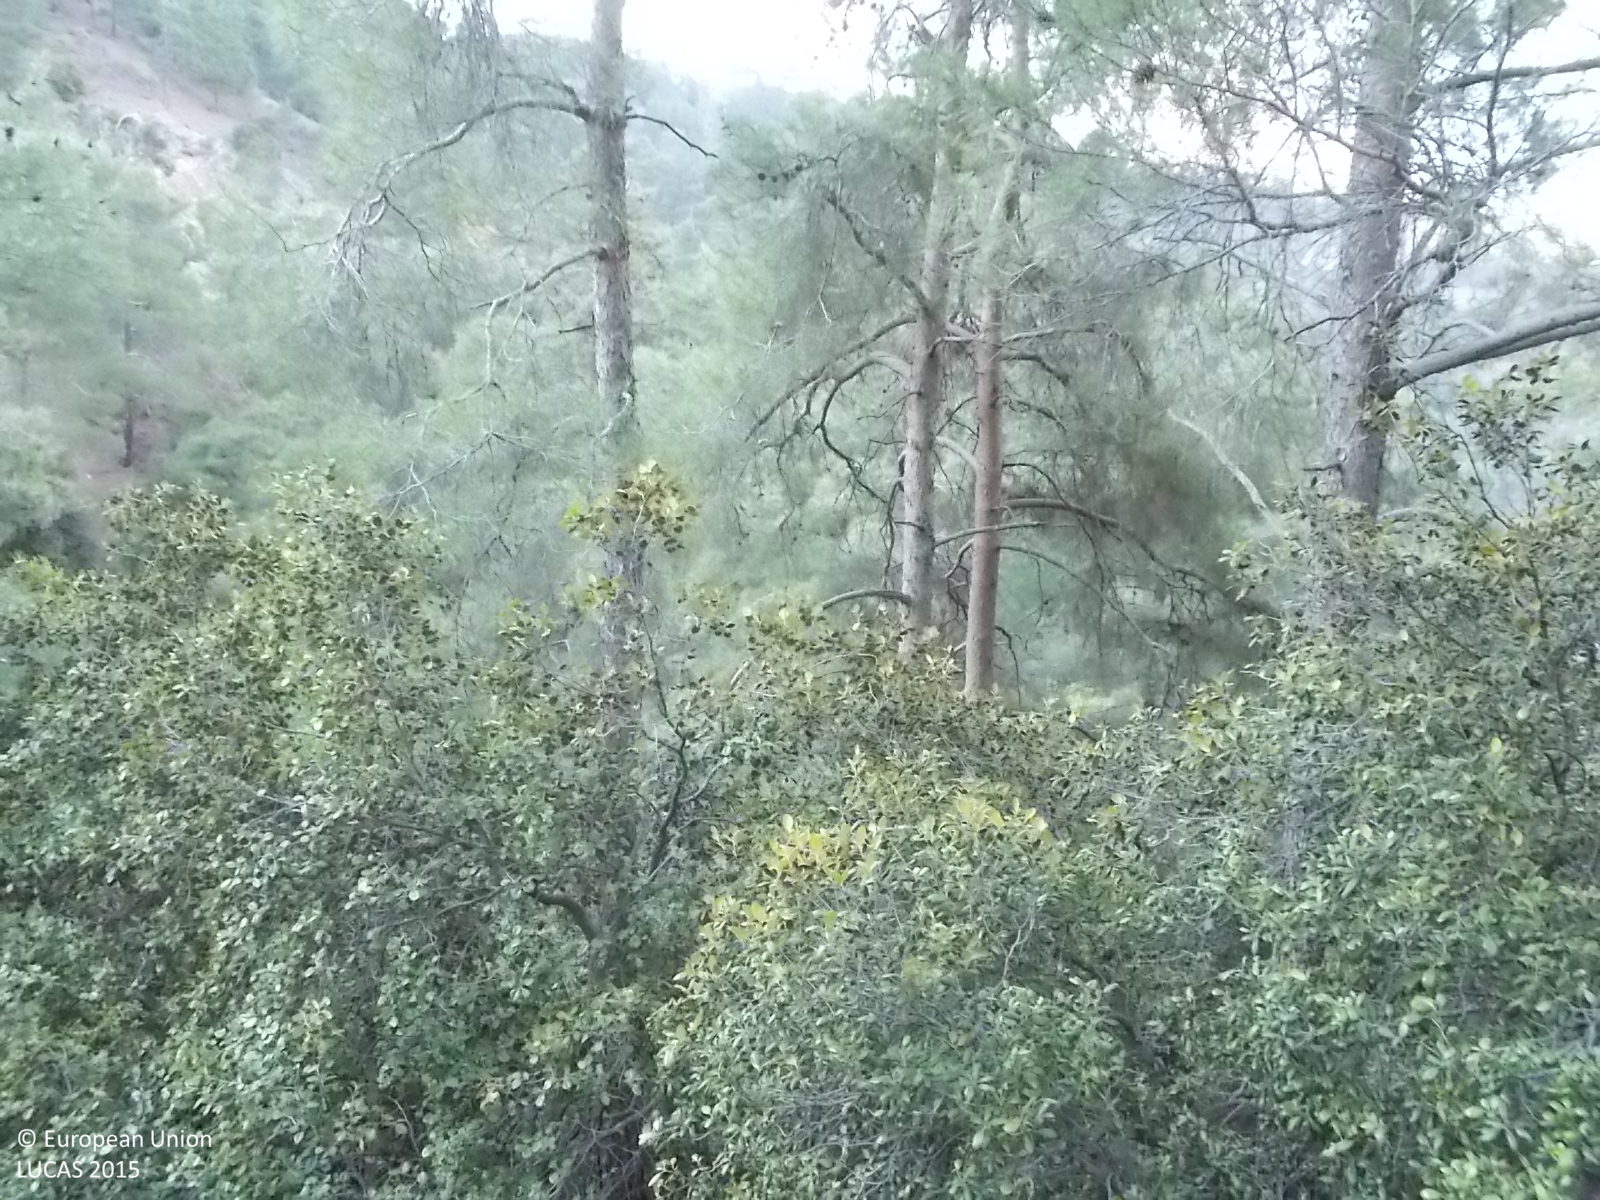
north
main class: Woodland
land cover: Pine dominated mixed woodland
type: coniferous forest of the mediterranean region
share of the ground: > 75 %
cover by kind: coniferous forest trees 60 %, broadleaved forest trees 25 %, shrubs 10 %, unconsolidated bare surface 5 %
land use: Forestry
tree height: > 5 m
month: June
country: CY
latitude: 35.0570
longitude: 32.6275
